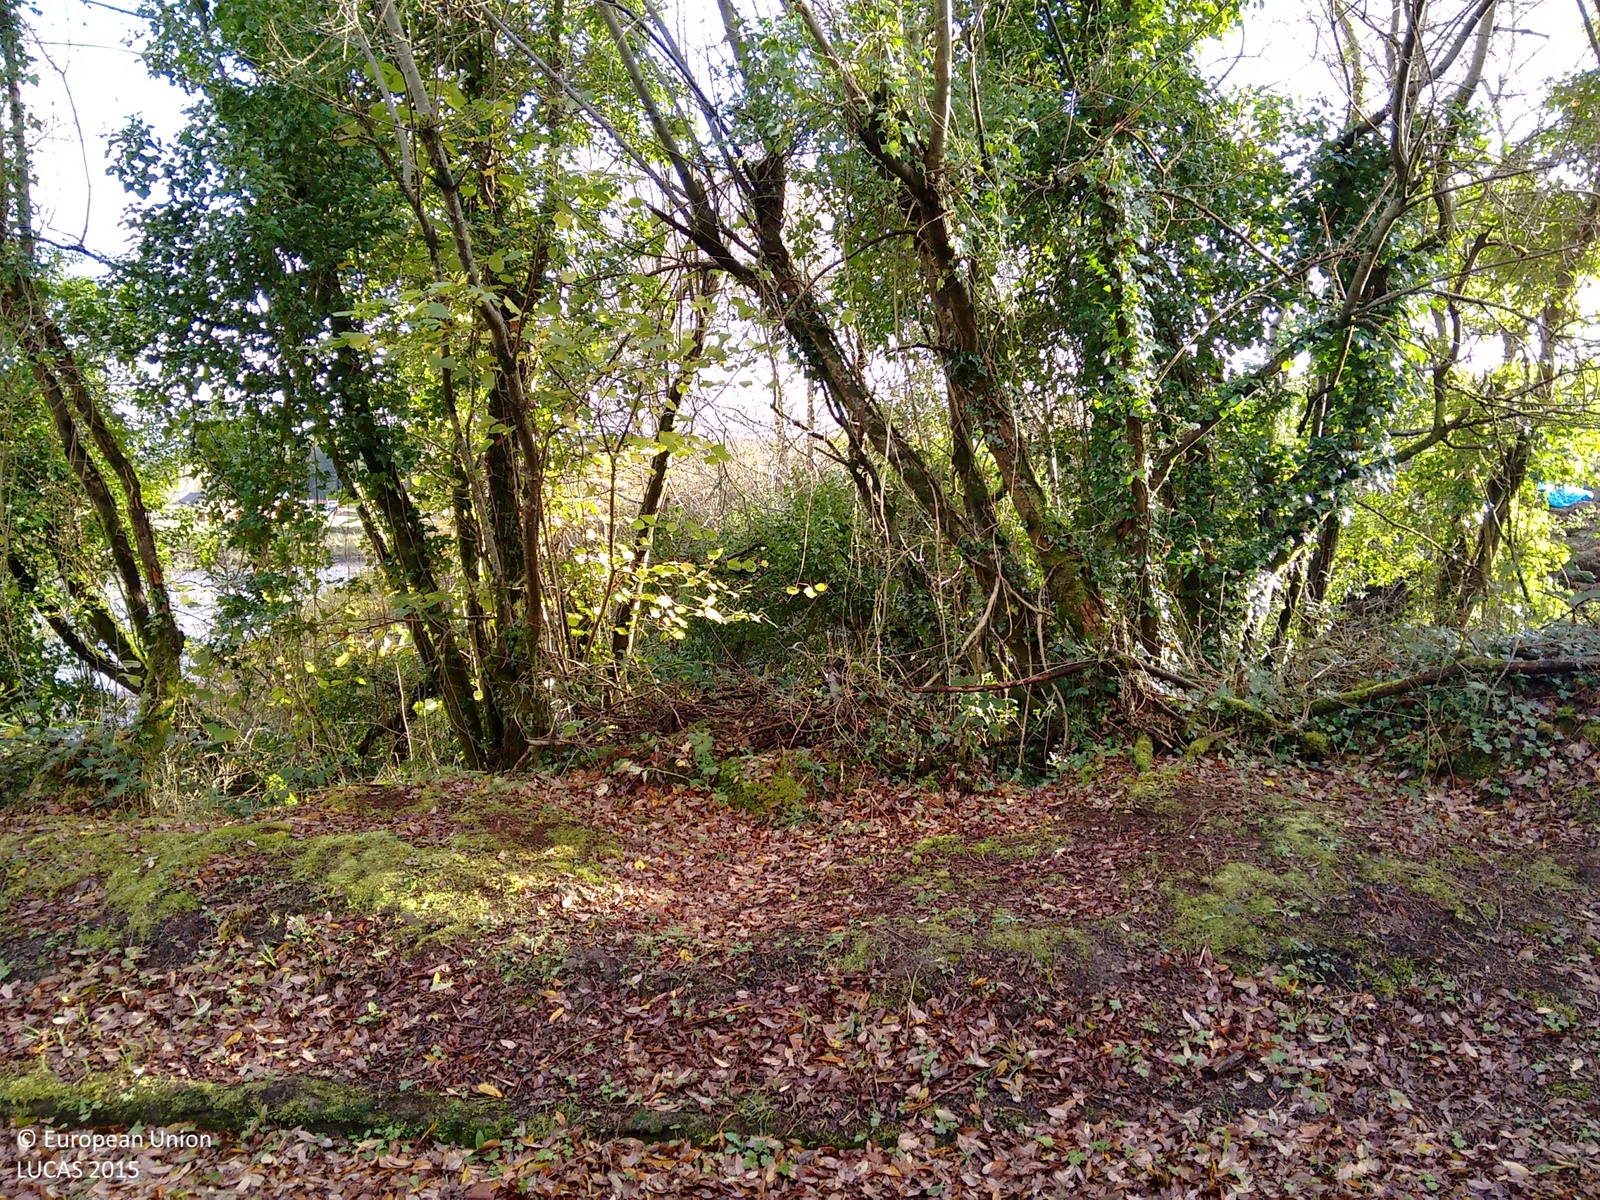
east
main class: Woodland
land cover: Broadleaved woodland
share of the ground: > 75 %
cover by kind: broadleaved forest trees 80 %, herbaceous plants 20 %
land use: Semi-natural and natural areas not in use
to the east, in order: Grass margins; Paved roads, cycling and walking lanes; Grass margins; Electric lines; Broadleaved woodland; Shruby margins; Grassland without tree/shrub cover; Lines of trees; Sand; Transitional water bodies; Paved roads, cycling and walking lanes; Transitional water bodies
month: November
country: IE
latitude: 54.6493
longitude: -8.4292
